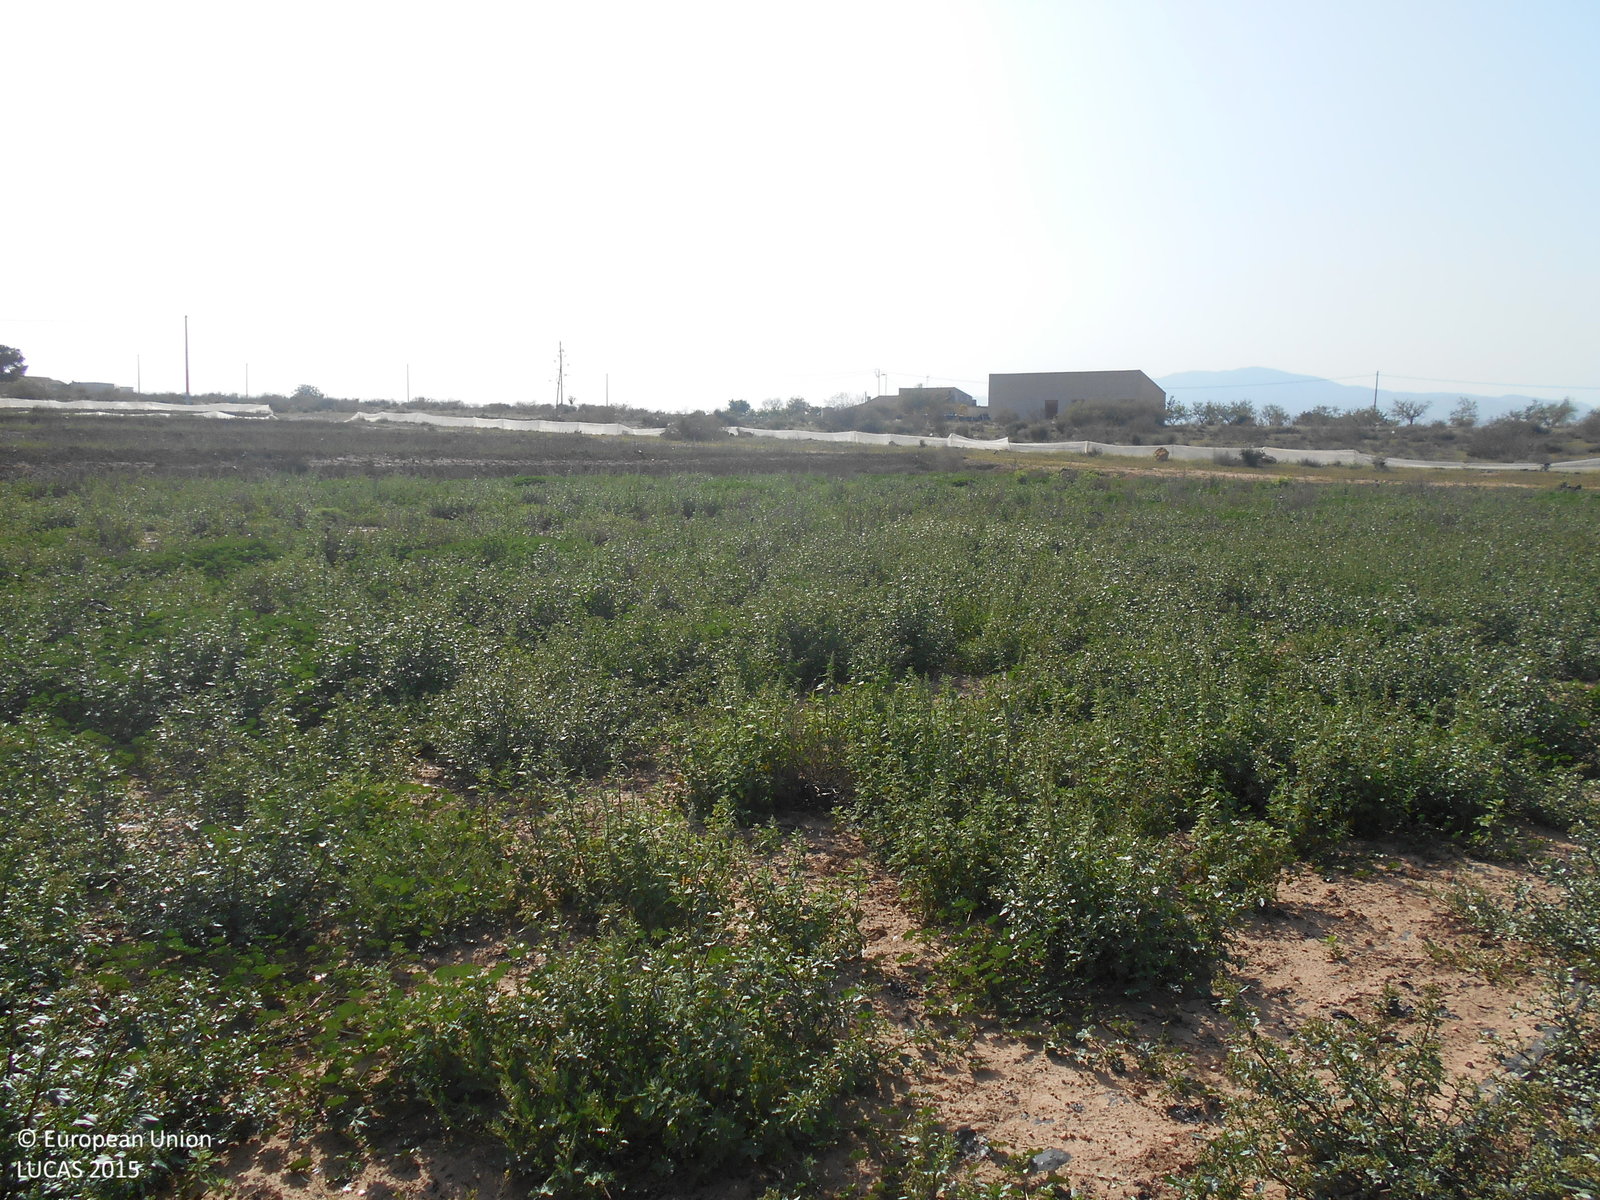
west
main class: Grassland
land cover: Spontaneously vegetated surfaces
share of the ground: 50 - 75 %
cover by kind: herbaceous plants 70 %, unconsolidated bare surface 30 %
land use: Fallow land
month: April
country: ES
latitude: 37.7095
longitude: -1.4727
